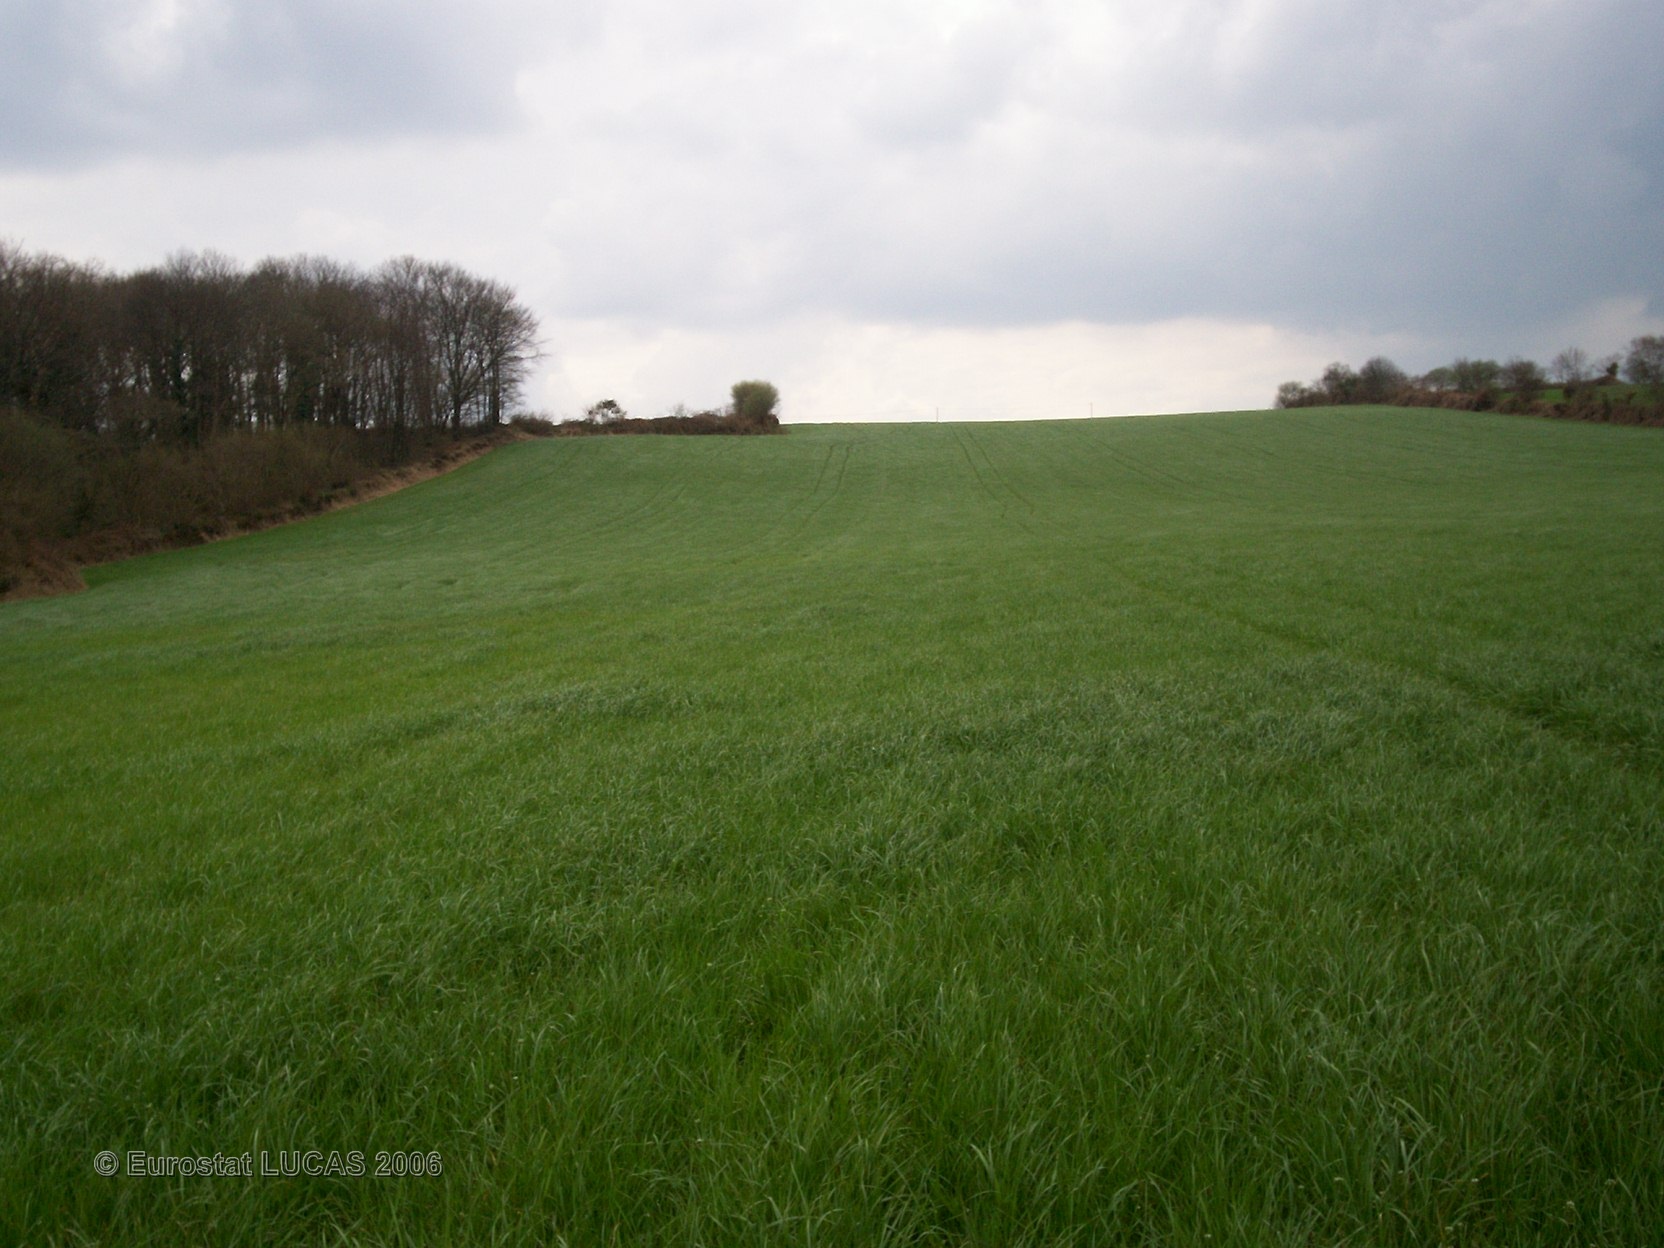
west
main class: Grassland
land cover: Grassland without tree/shrub cover
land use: Agriculture (excluding fallow land and kitchen gardens)
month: April
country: FR
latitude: 48.4791
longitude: -3.6780
